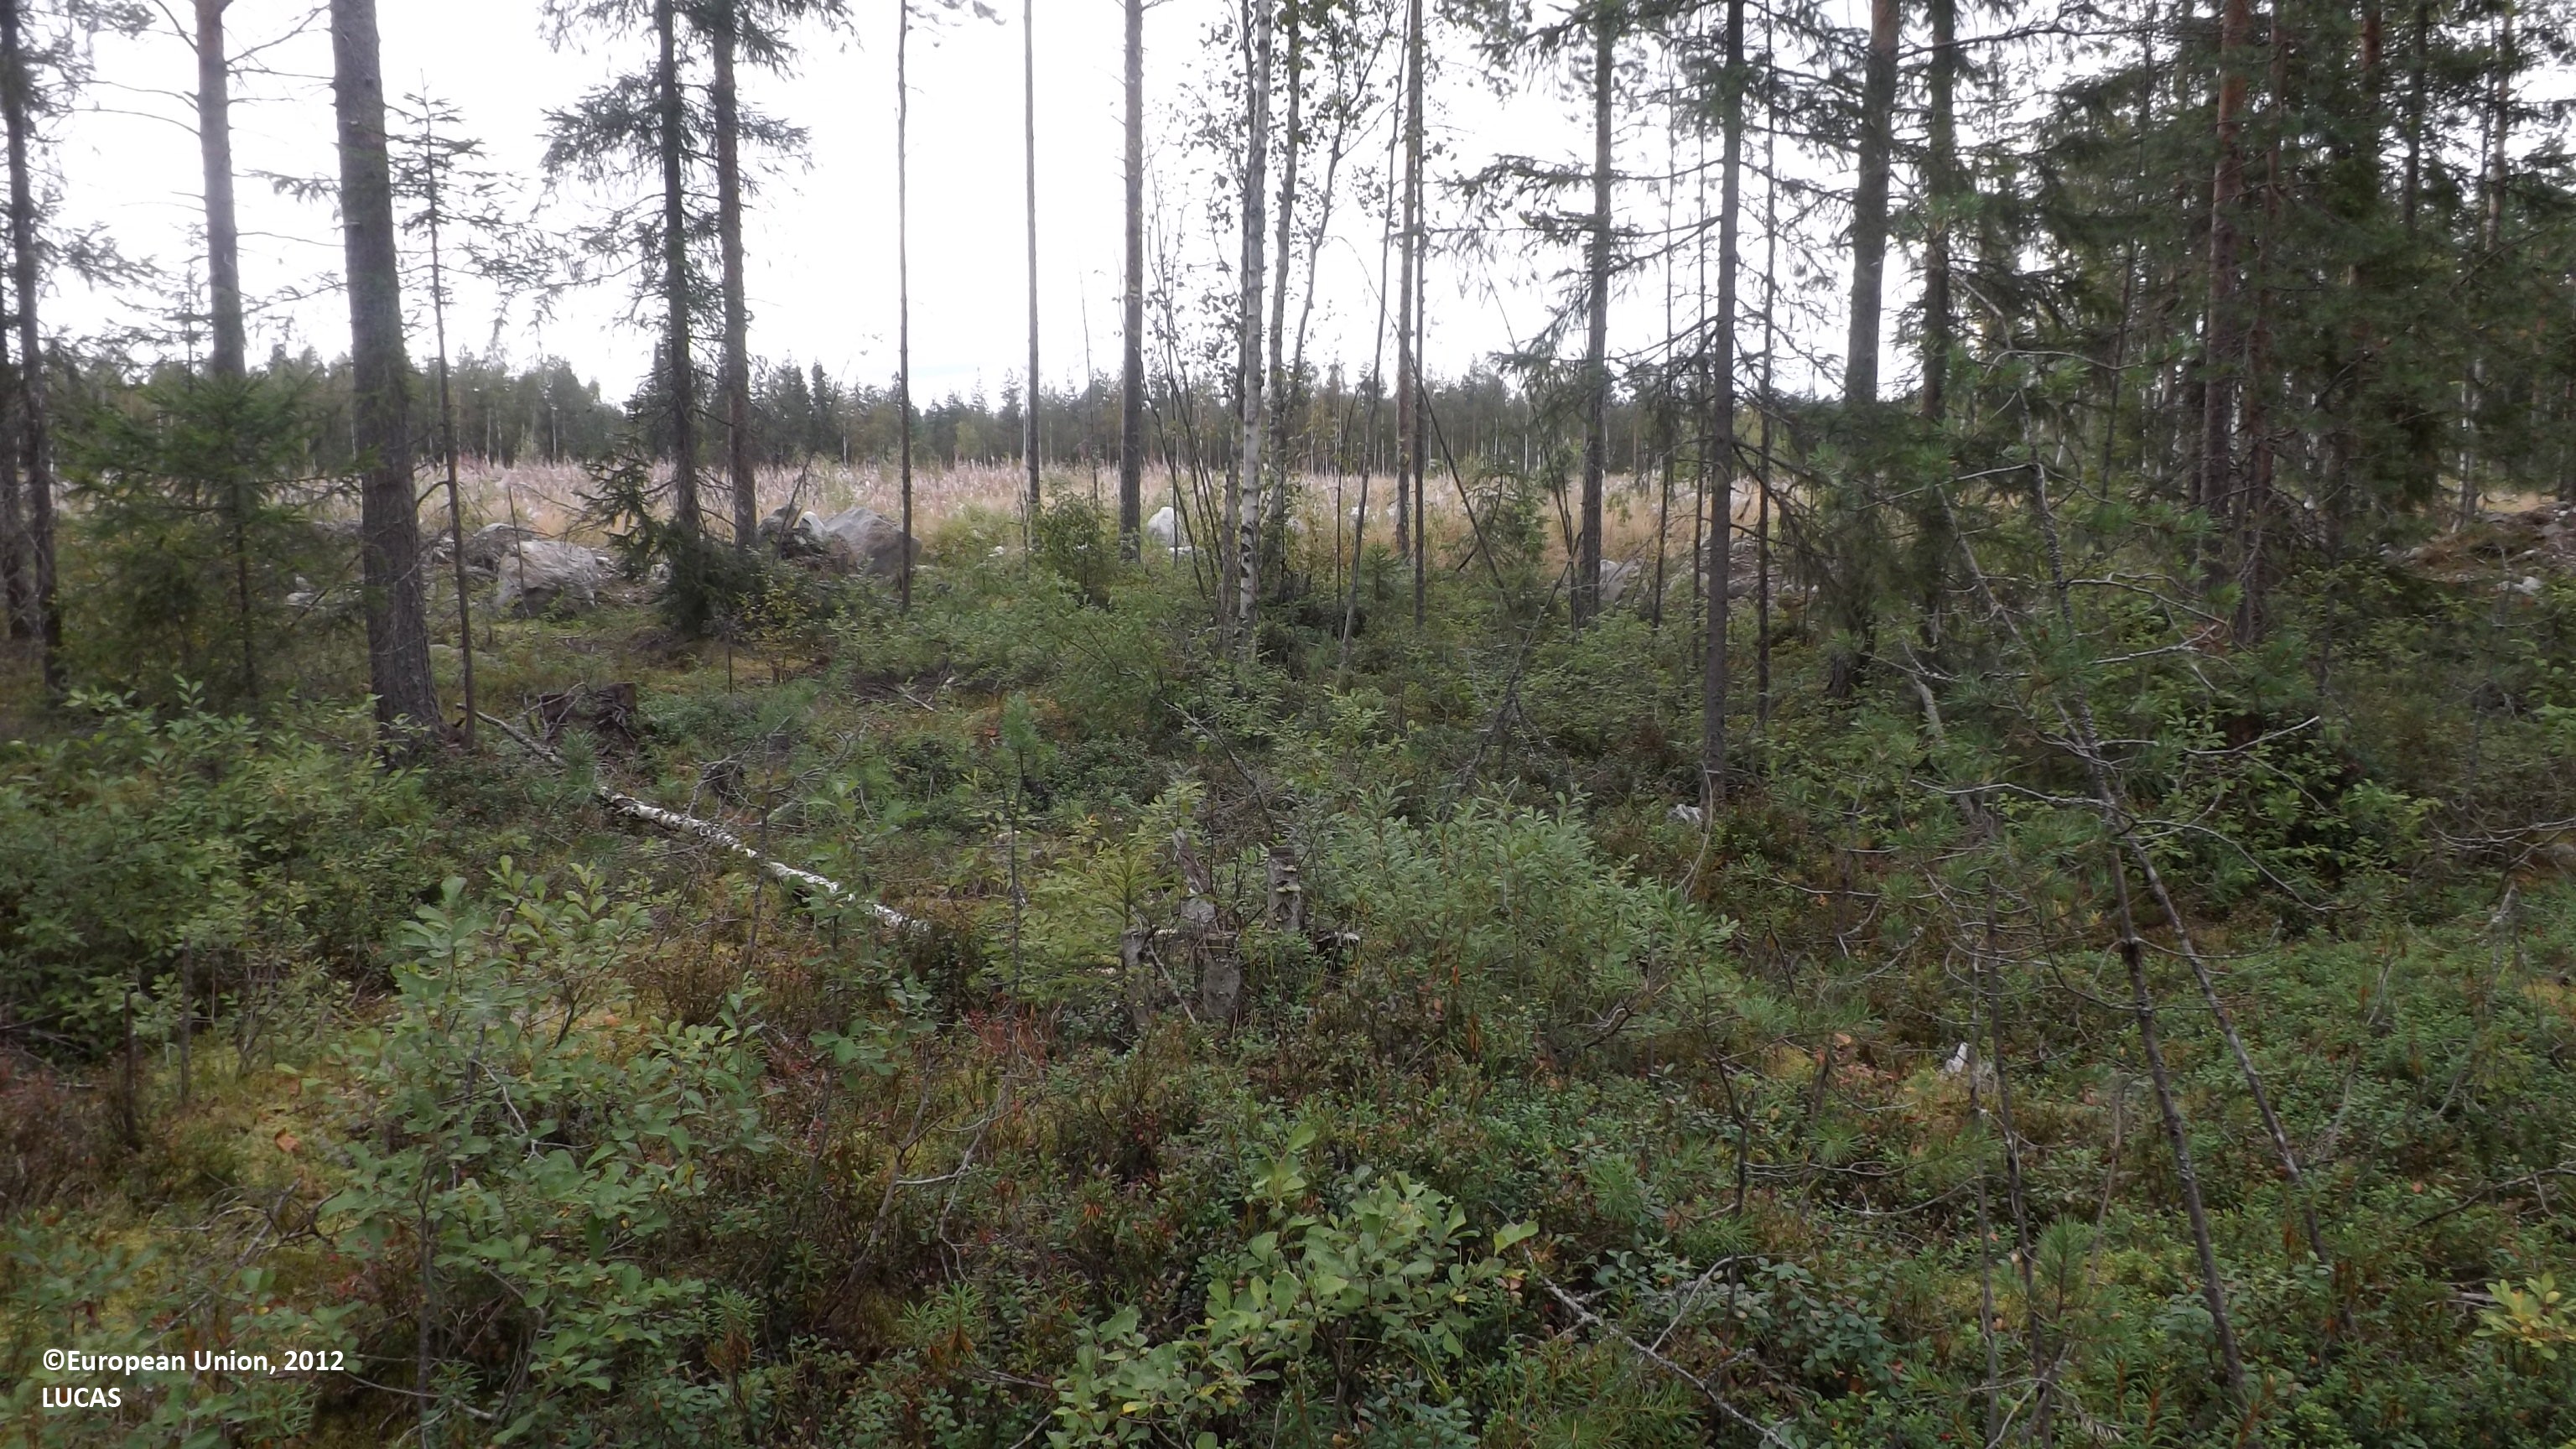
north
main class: Woodland
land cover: Other mixed woodland
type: boreal forest
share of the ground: 25 - 50 %
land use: Forestry
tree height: > 5 m
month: August
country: FI
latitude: 63.9639
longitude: 23.9294
